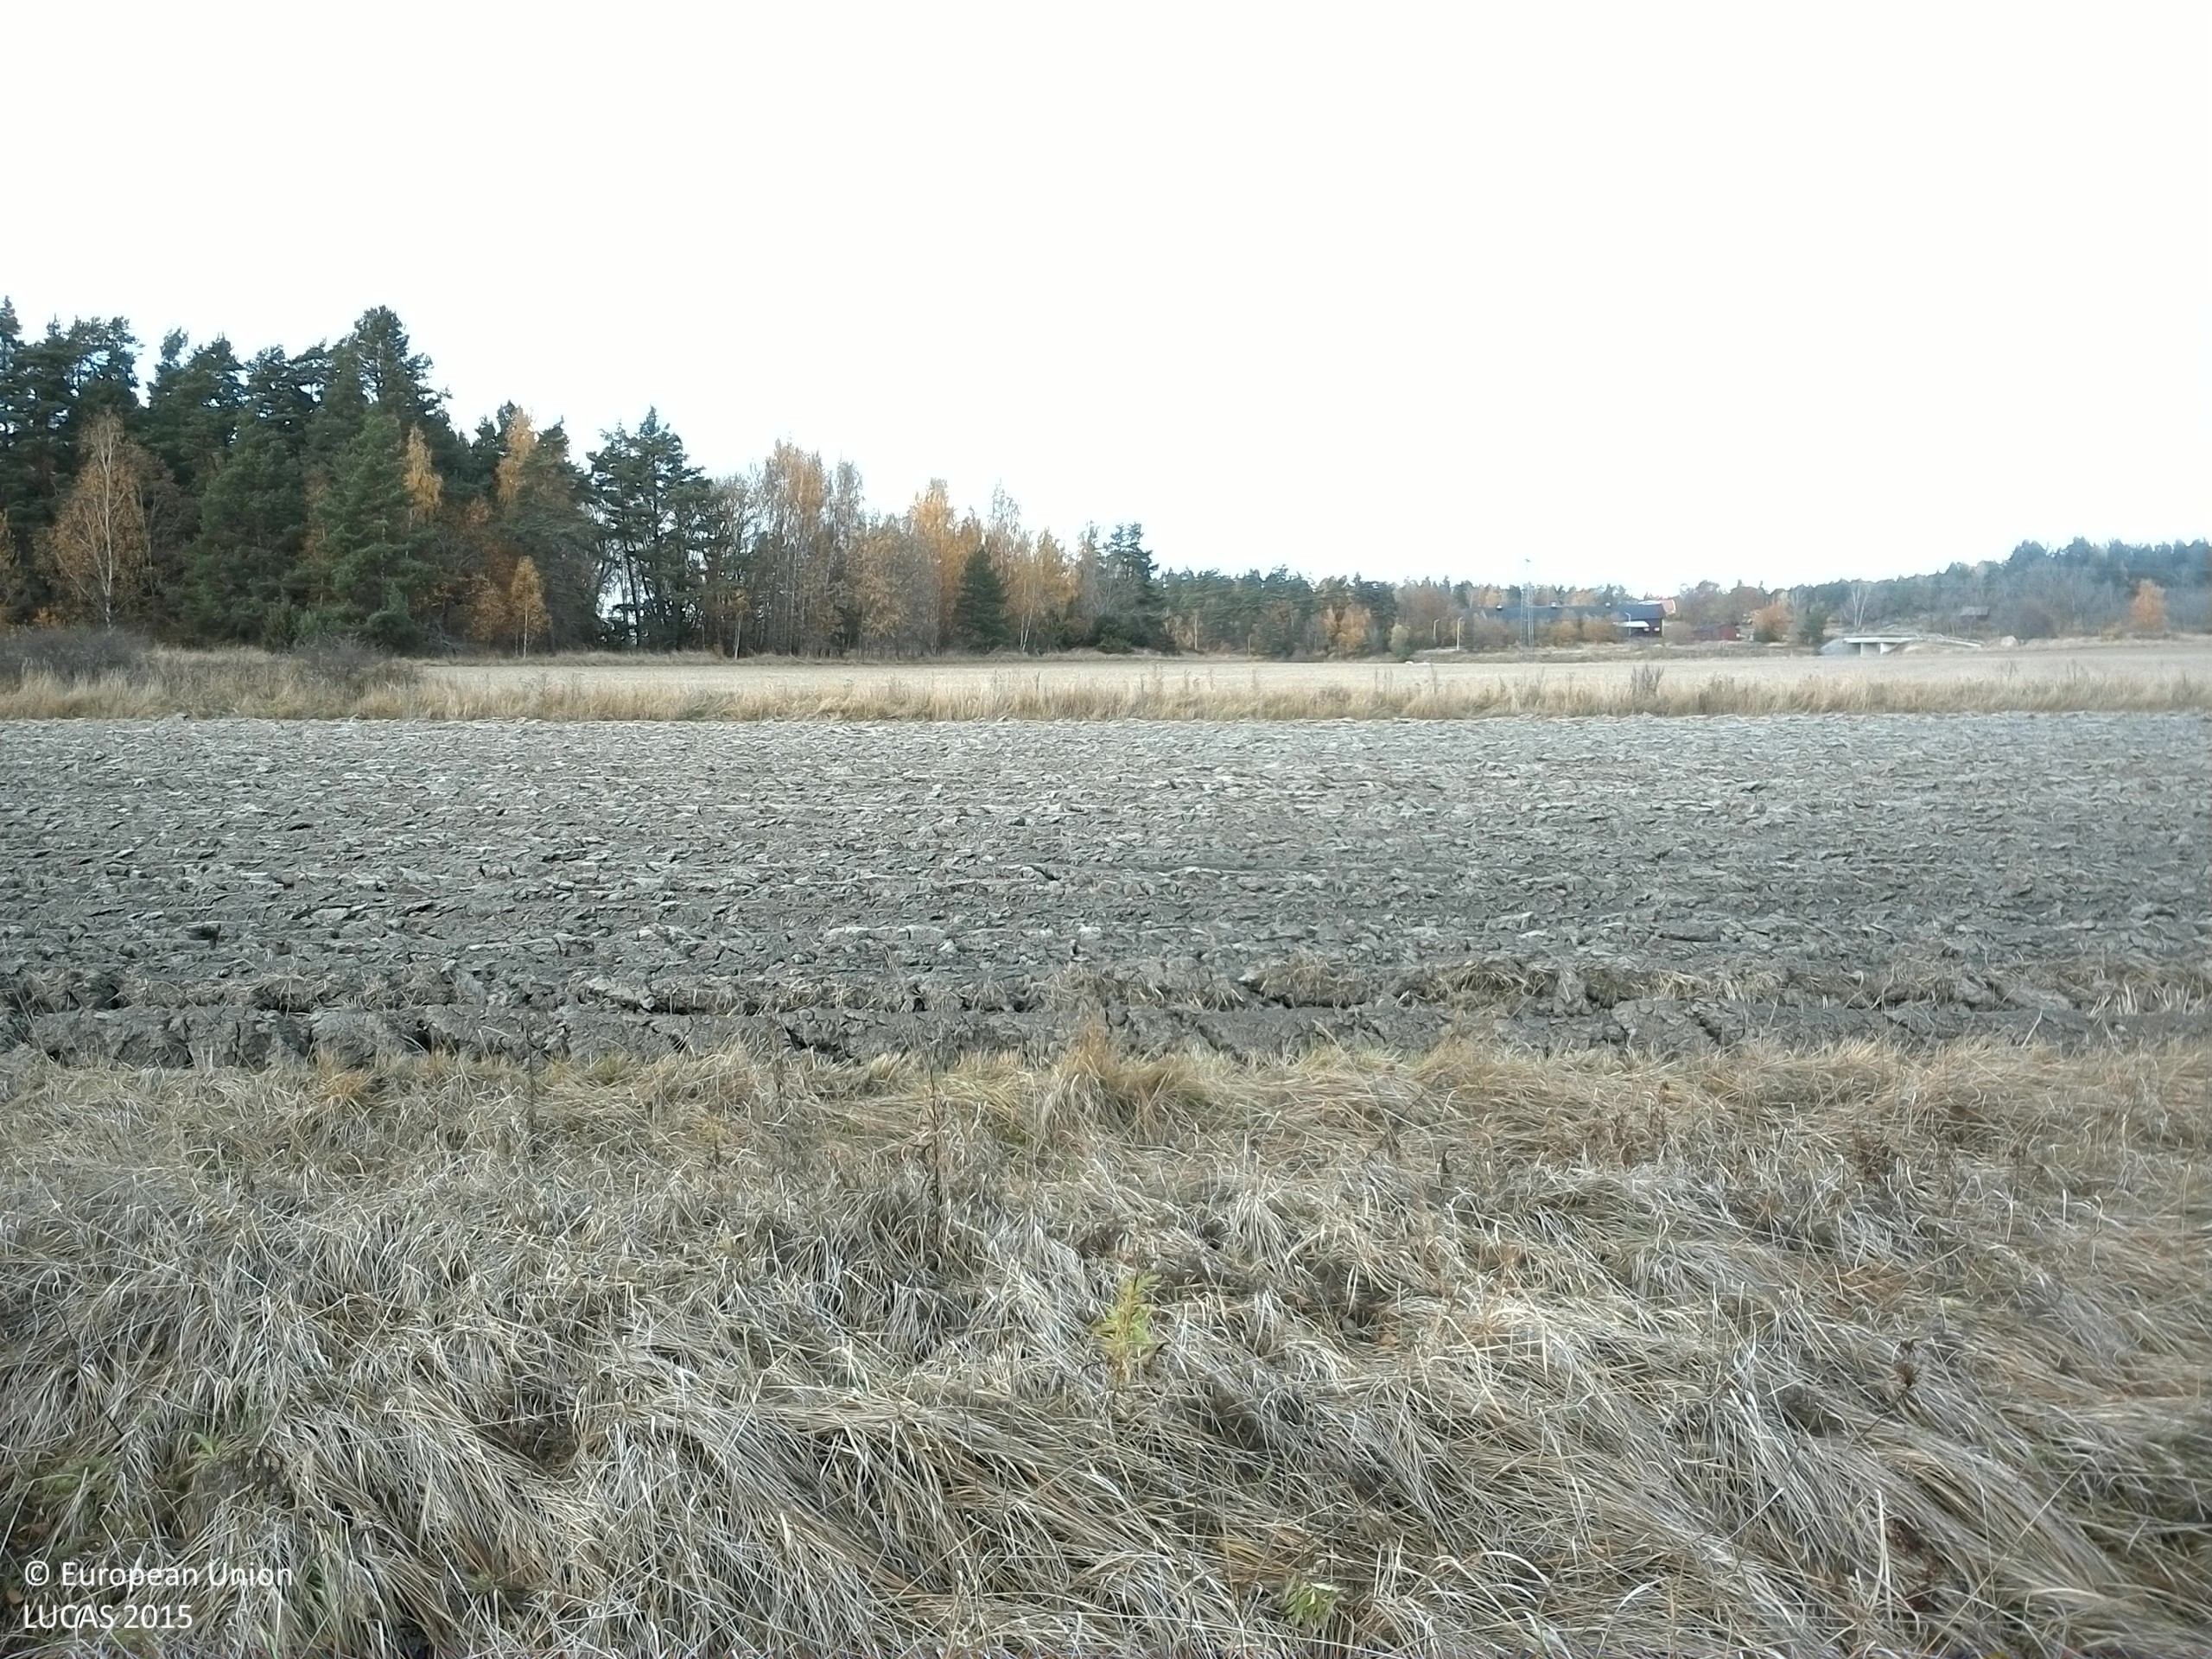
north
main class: Grassland
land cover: Grassland with sparse tree/shrub cover
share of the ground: > 75 %
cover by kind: herbaceous plants 95 %, coniferous forest trees 5 %
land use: Semi-natural and natural areas not in use
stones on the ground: < 10 %
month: October
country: SE
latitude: 59.3777
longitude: 16.5582
